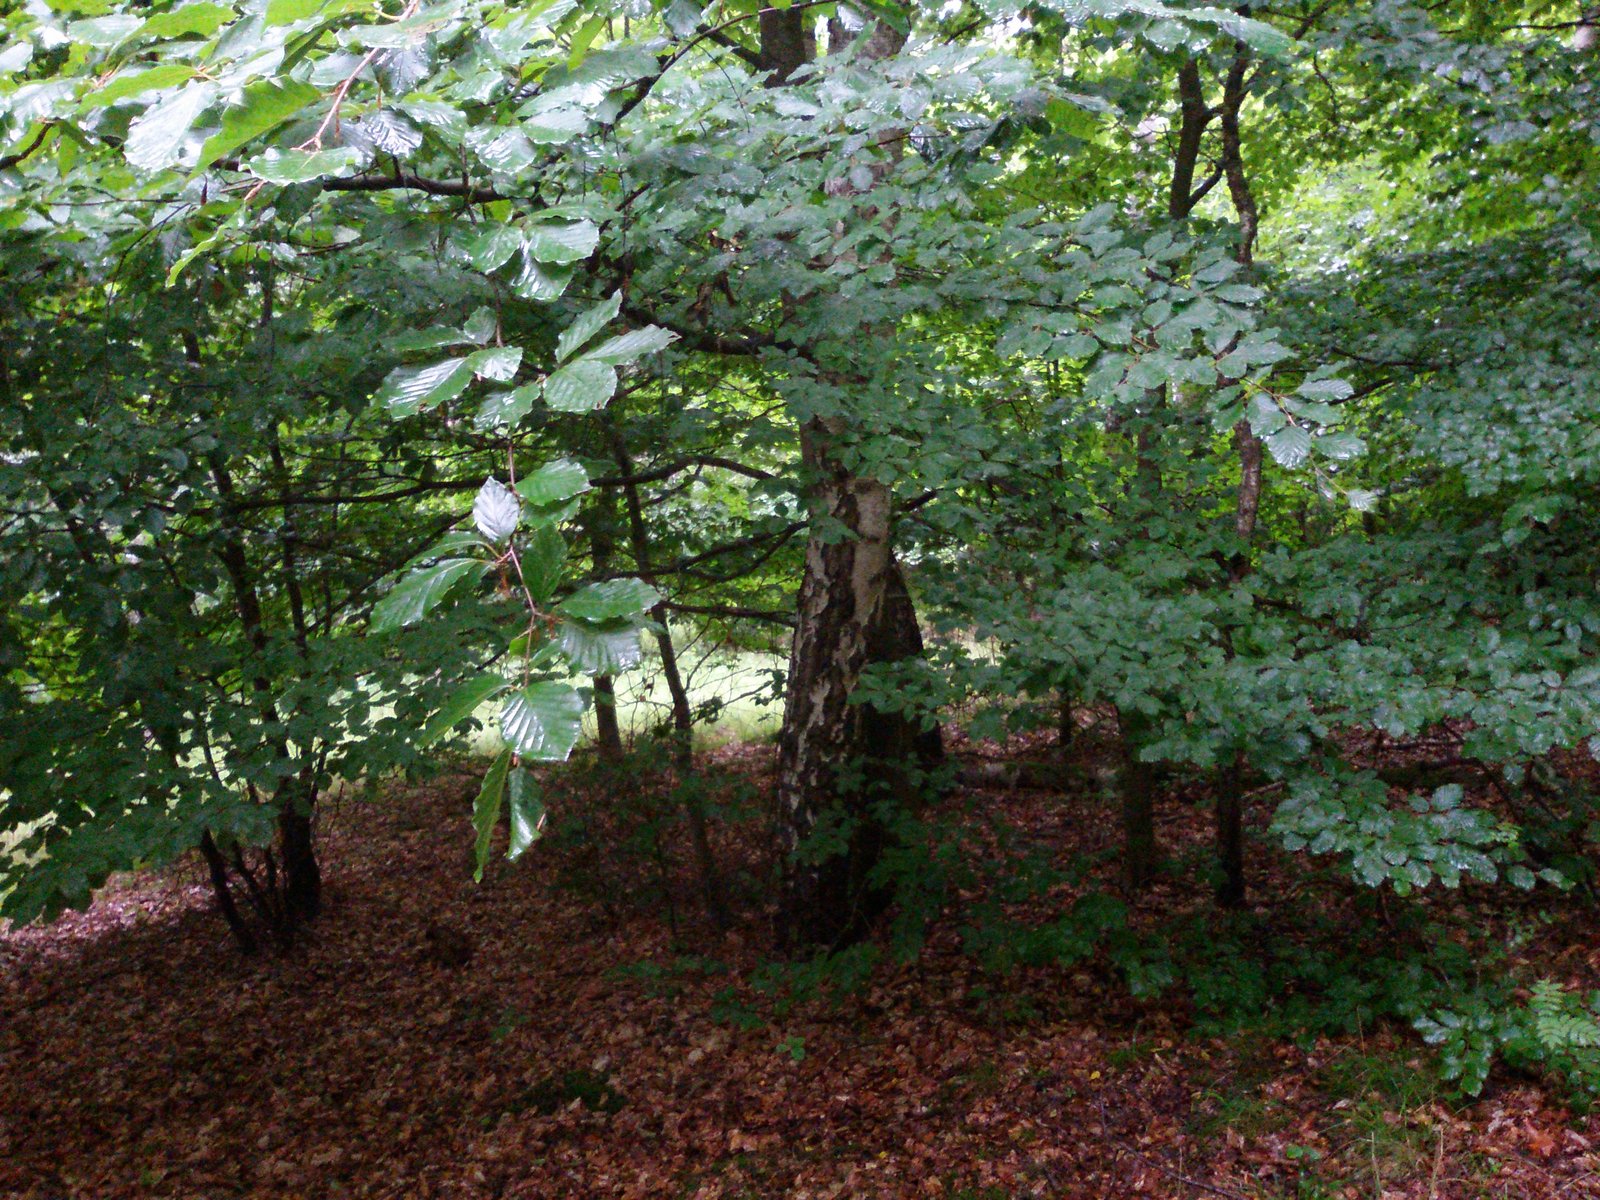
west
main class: Woodland
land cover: Broadleaved woodland
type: beech forest
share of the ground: > 75 %
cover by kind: broadleaved forest trees 90 %, herbaceous plants 5 %, lichens and mosses 5 %
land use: Forestry
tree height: > 5 m
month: July
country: PL
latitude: 53.7678
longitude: 17.1552
